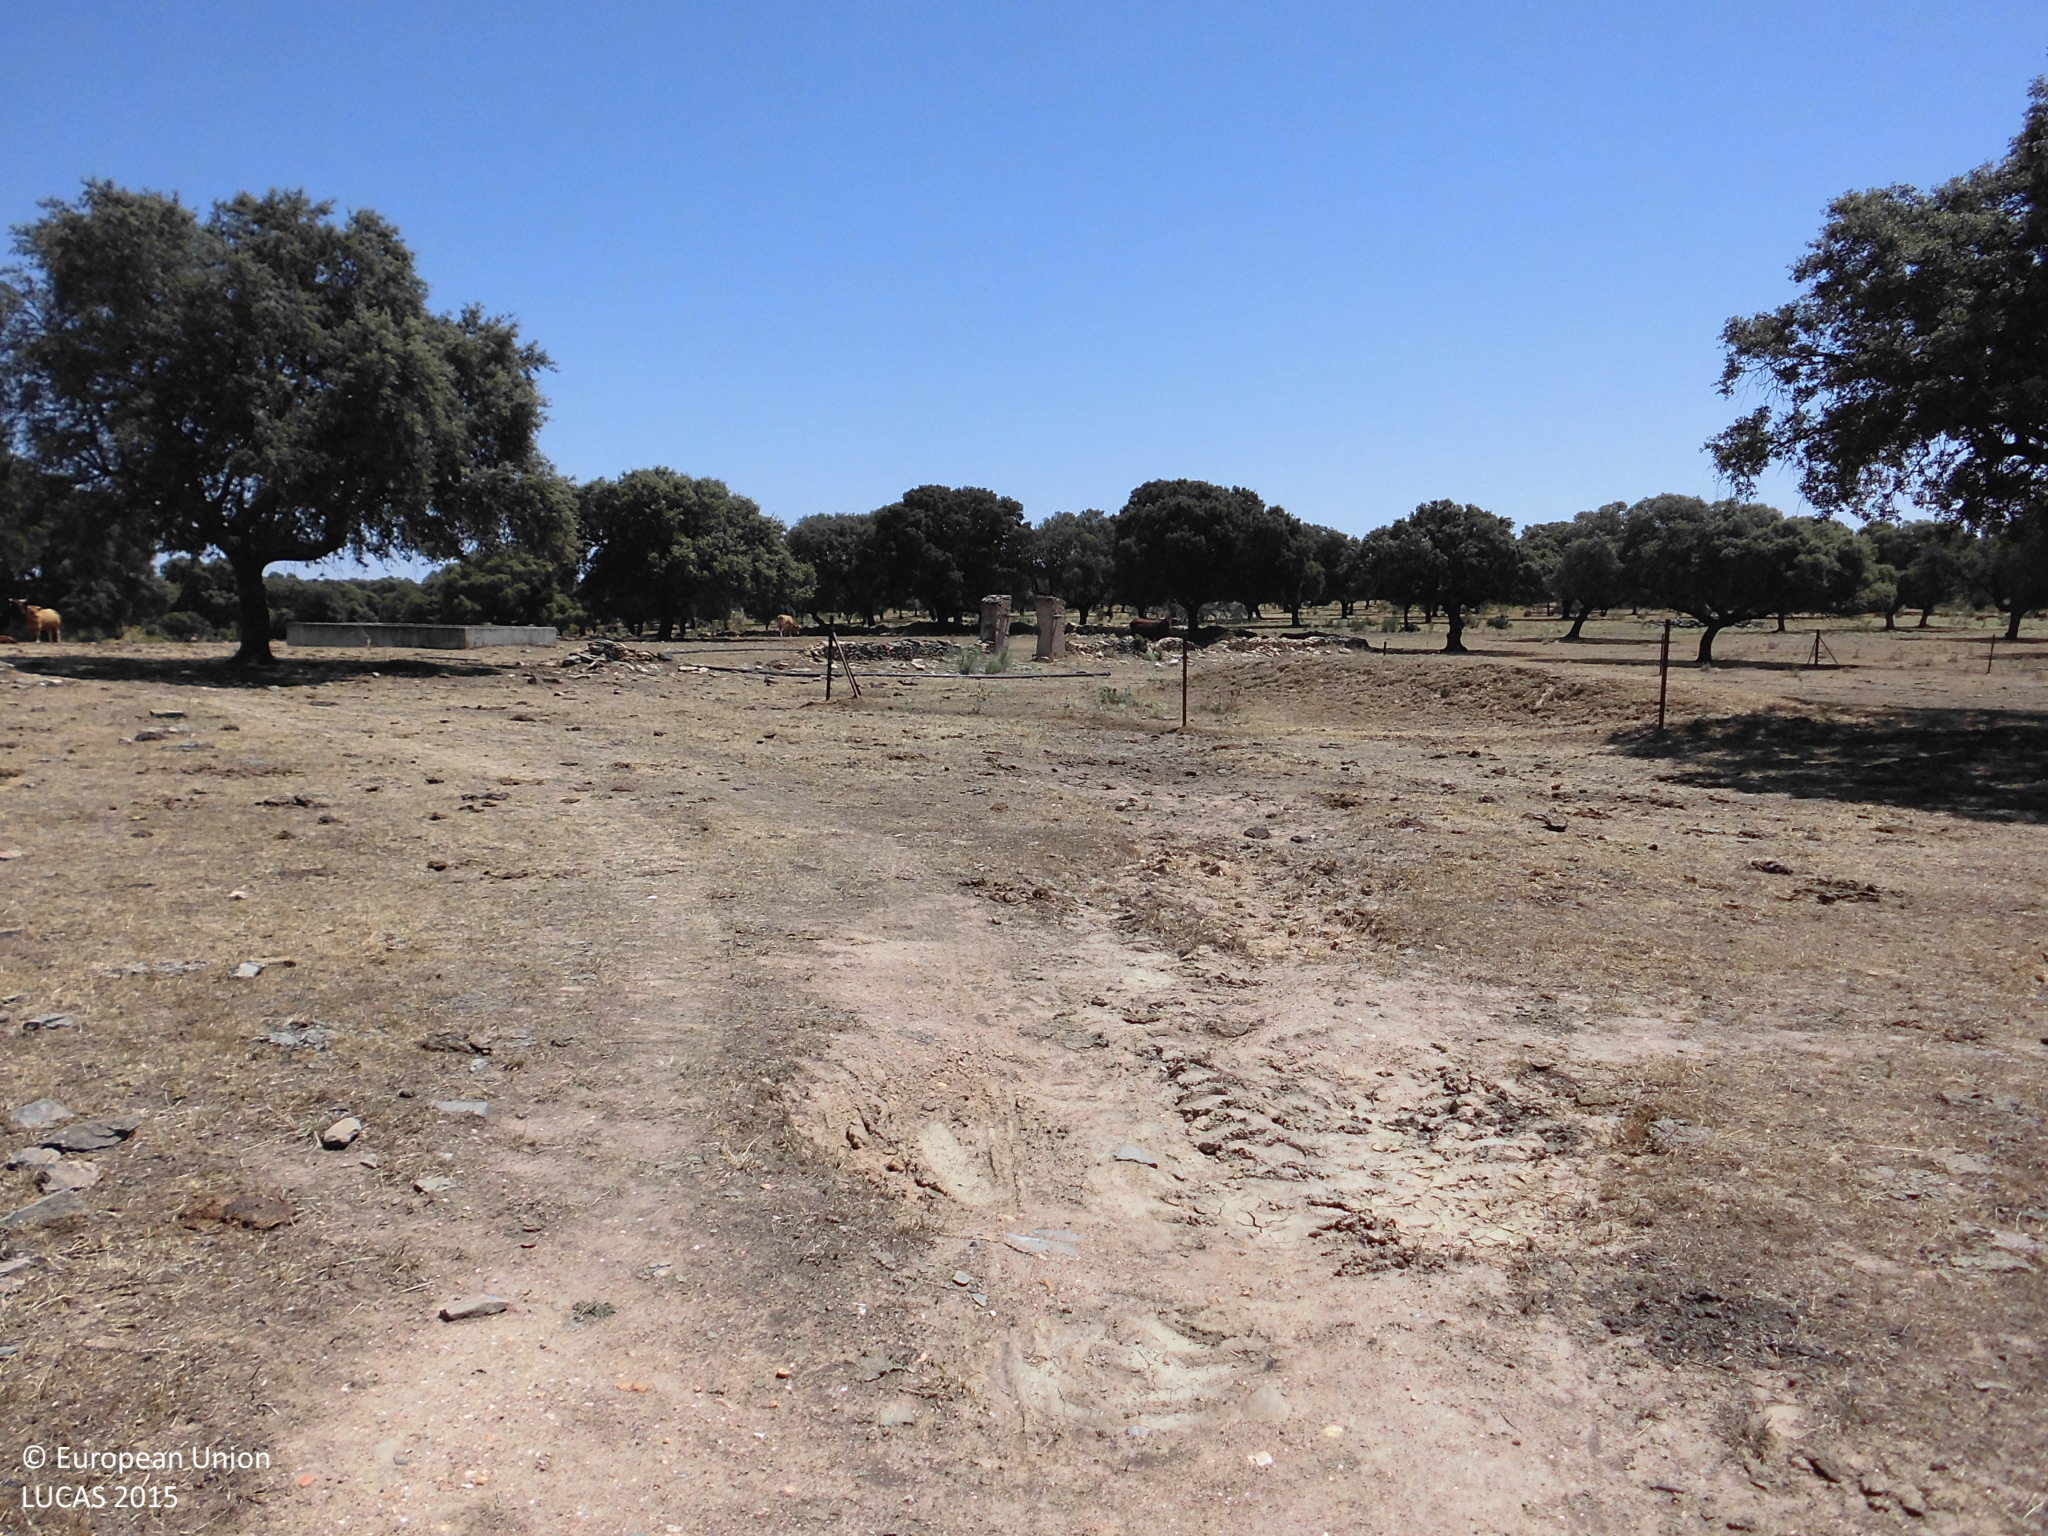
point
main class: Woodland
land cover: Broadleaved woodland
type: broadleaved evergreen forest
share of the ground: 10 - 25 %
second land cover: Grassland without tree/shrub cover
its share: > 75 %
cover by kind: herbaceous plants 75 %, broadleaved forest trees 25 %
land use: Forestry
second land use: Agriculture (excluding fallow land and kitchen gardens)
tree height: > 5 m
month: June
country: ES
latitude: 39.6981
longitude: -6.0065
